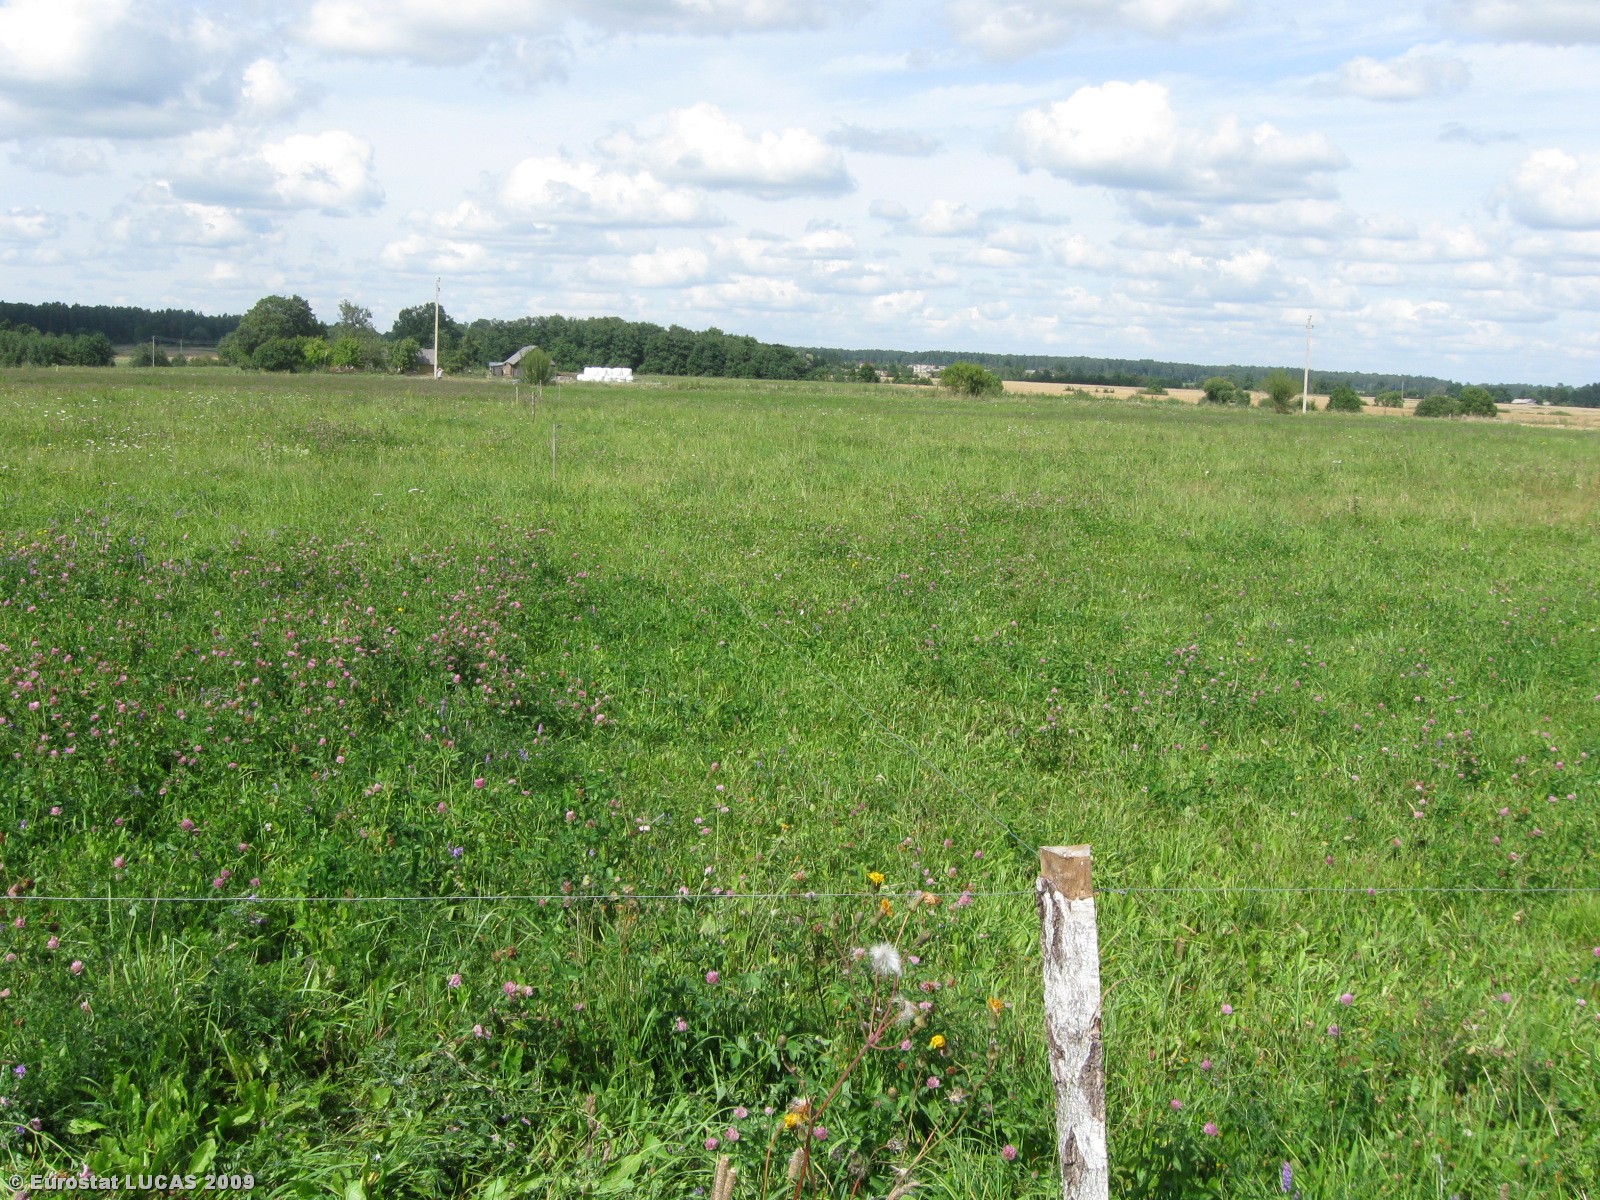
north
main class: Cropland
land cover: Barley
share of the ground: > 75 %
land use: Agriculture (excluding fallow land and kitchen gardens)
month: August
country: LT
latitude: 55.2088
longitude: 22.6840
